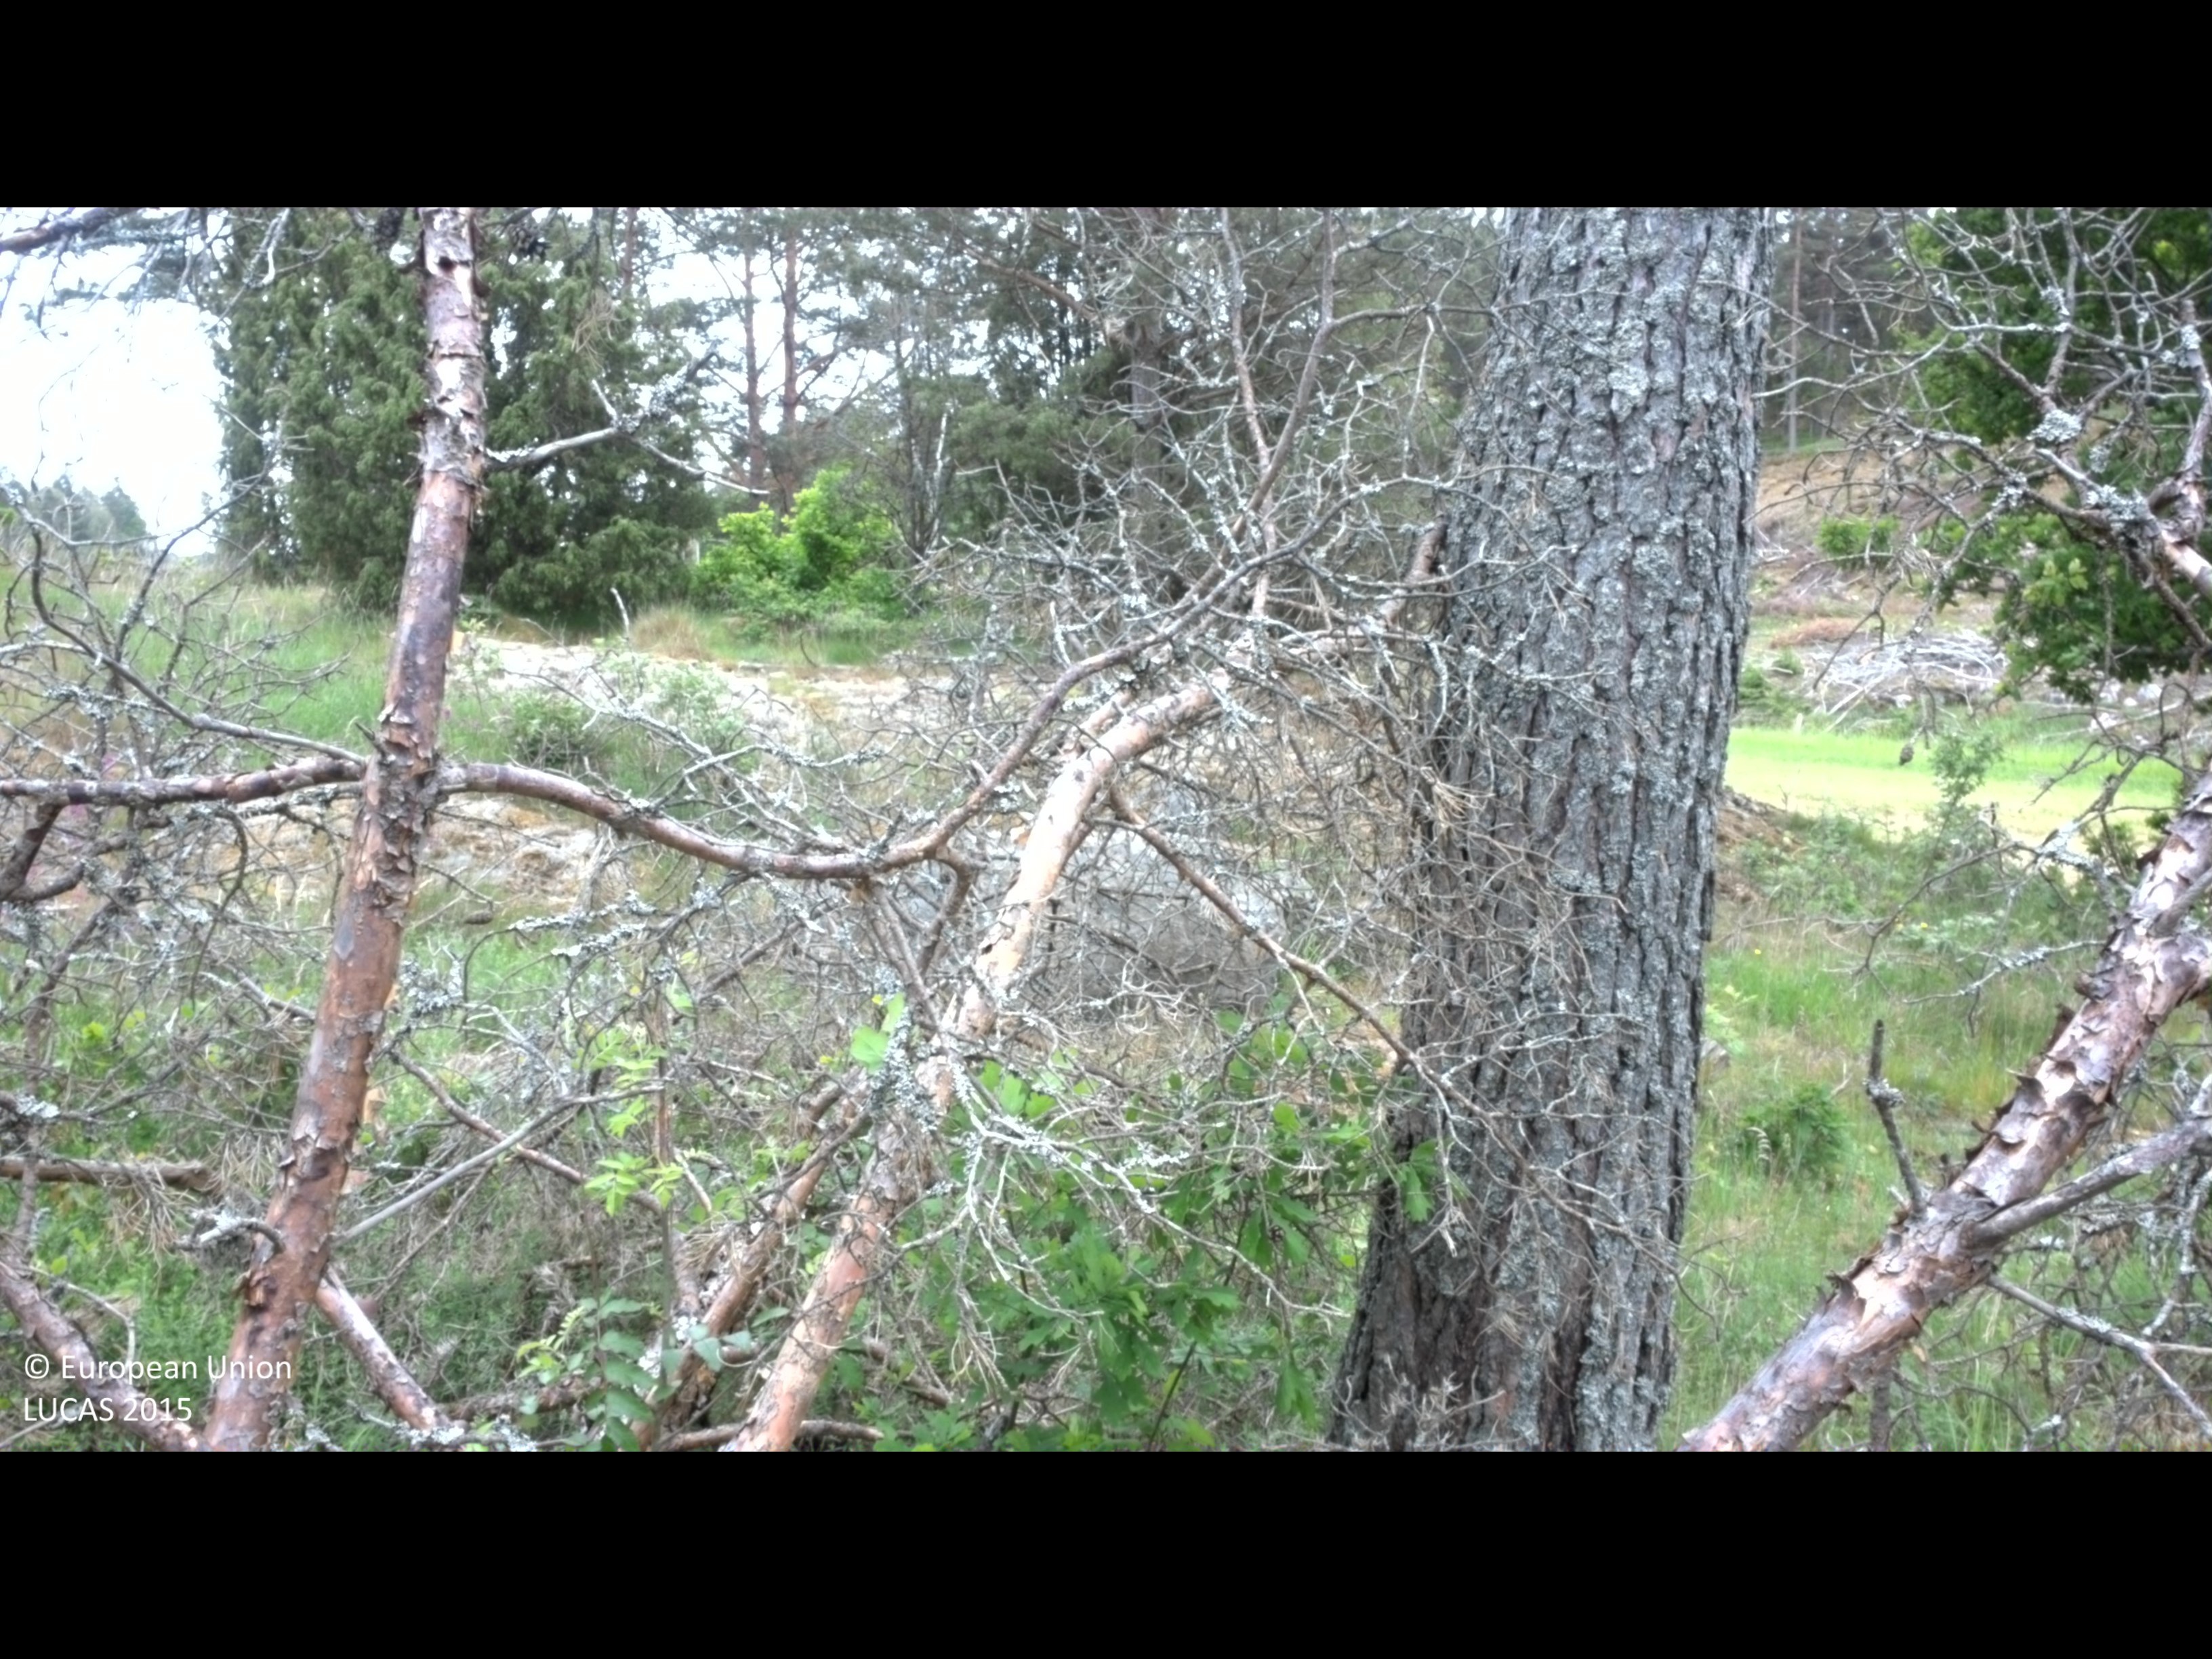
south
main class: Woodland
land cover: Pine dominated mixed woodland
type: hemiboreal forest and nemoral coniferous forest and mixed broadleaved-coniferous forest
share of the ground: 25 - 50 %
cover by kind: coniferous forest trees 30 %, shrubs 25 %, broadleaved forest trees 20 %, lichens and mosses 20 %, herbaceous plants 5 %
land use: Forestry
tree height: > 5 m
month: June
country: SE
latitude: 57.9846
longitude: 16.6107
